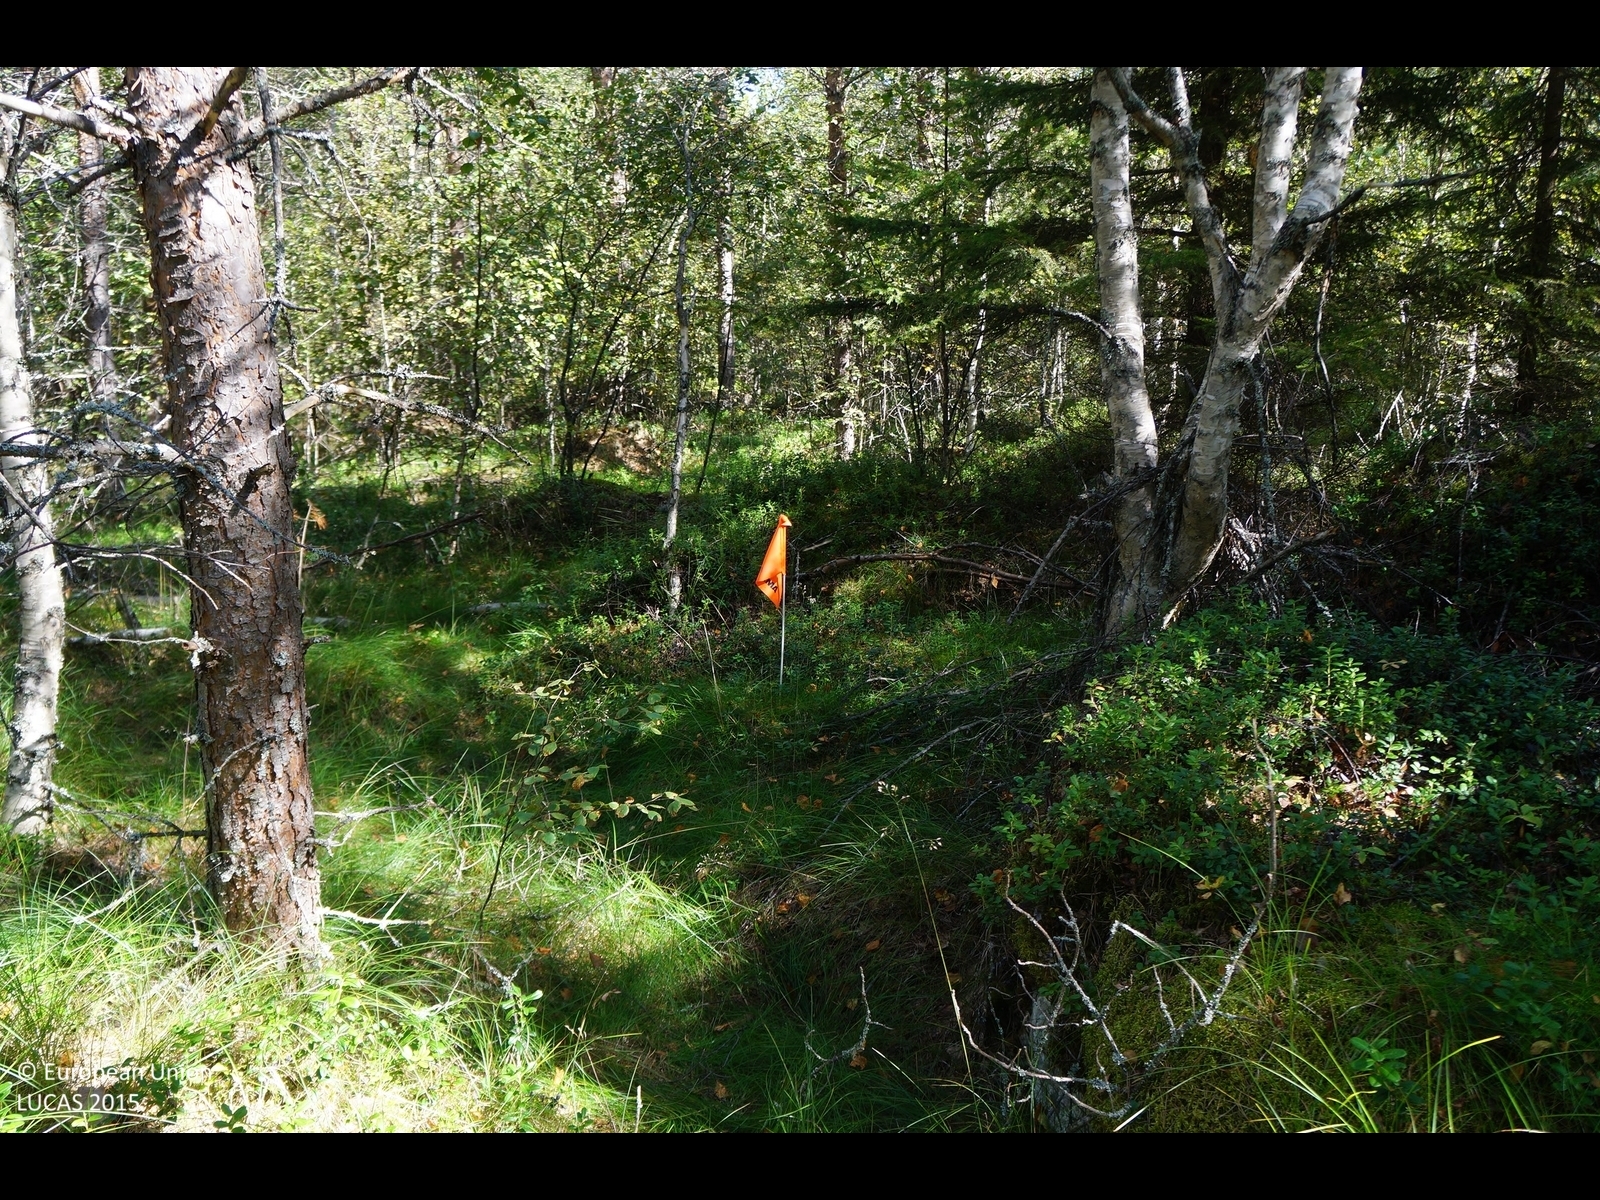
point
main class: Woodland
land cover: Pine dominated mixed woodland
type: boreal forest
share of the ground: 50 - 75 %
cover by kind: coniferous forest trees 50 %, broadleaved forest trees 20 %, herbaceous plants 15 %, shrubs 10 %, lichens and mosses 5 %
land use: Forestry
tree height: > 5 m
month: August
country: FI
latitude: 63.9640
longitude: 23.7217
